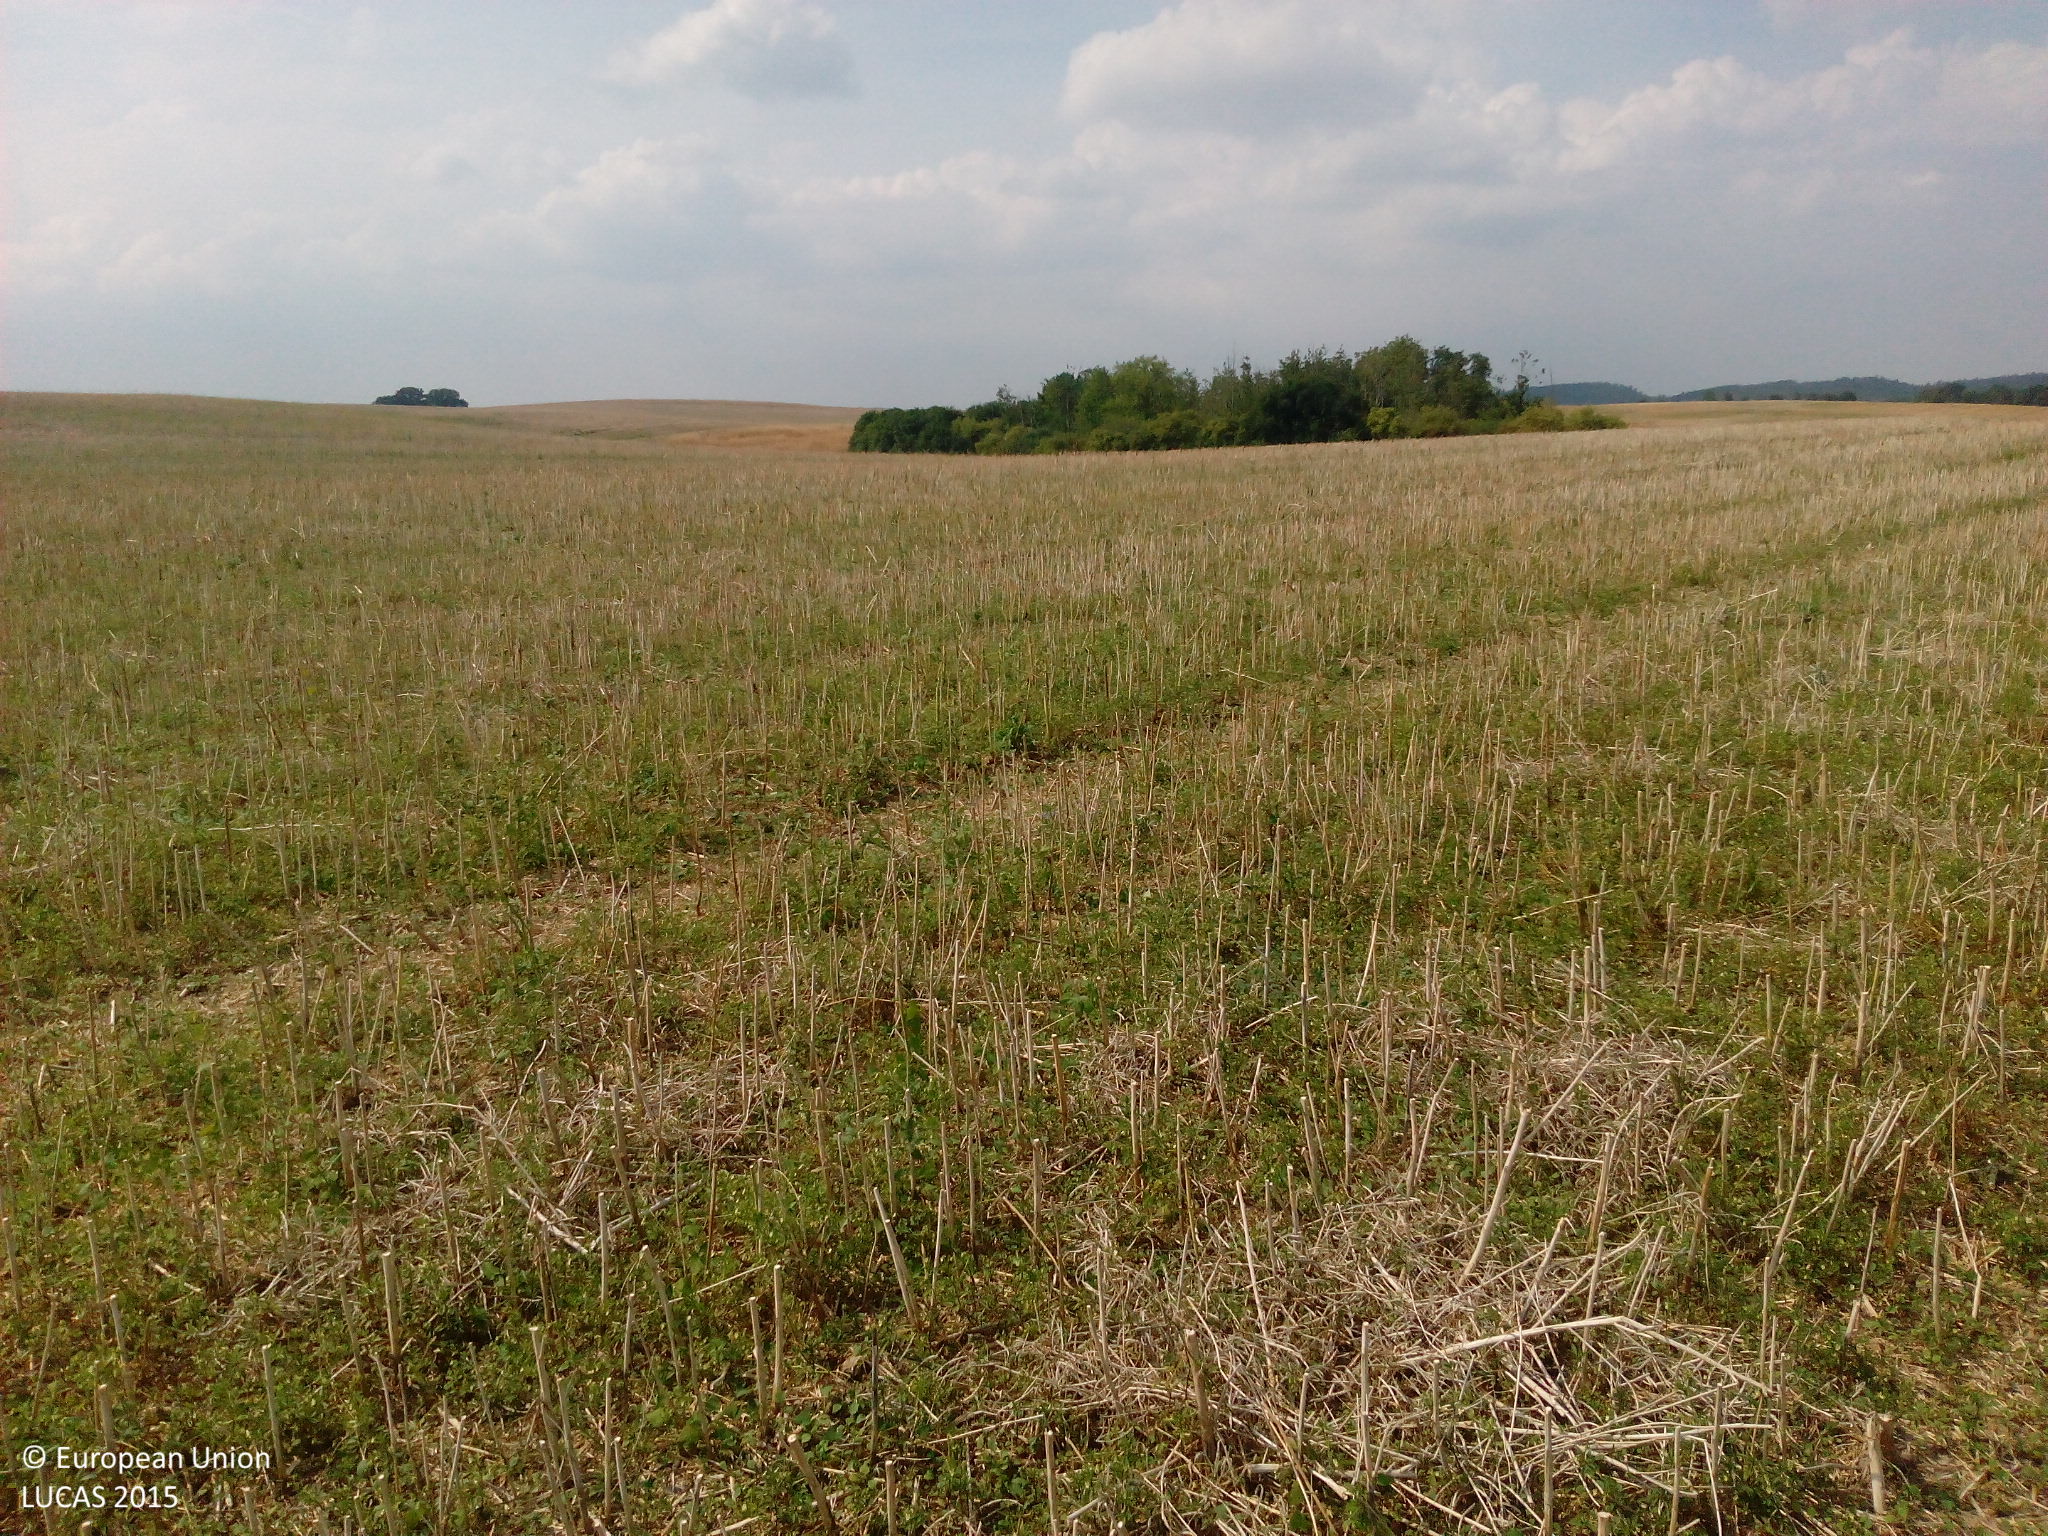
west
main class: Cropland
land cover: Rape and turnip rape
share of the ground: < 10 %
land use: Agriculture (excluding fallow land and kitchen gardens)
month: August
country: DE
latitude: 53.6973
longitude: 12.6195
